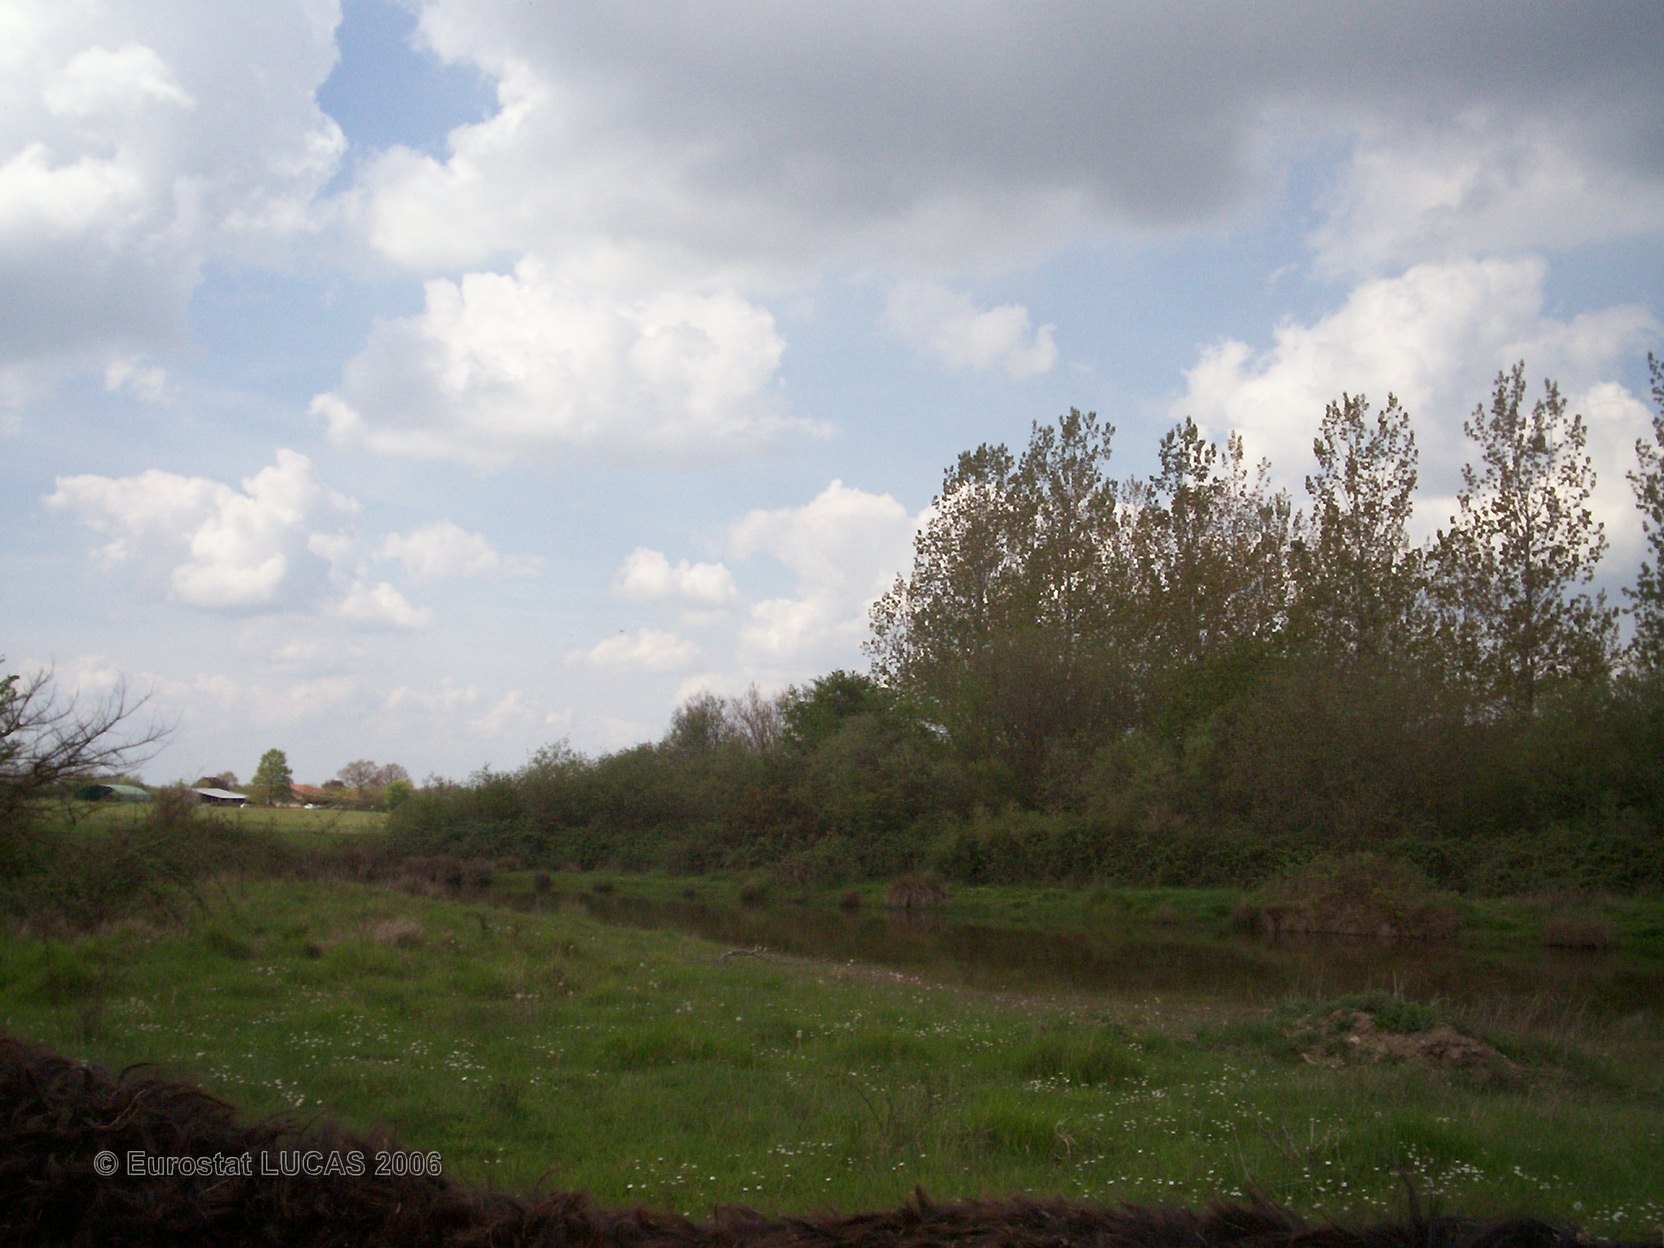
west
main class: Grassland
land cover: Grassland with sparse tree/shrub cover
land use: Agriculture (excluding fallow land and kitchen gardens)
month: April
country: FR
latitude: 46.3633
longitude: 0.5079
